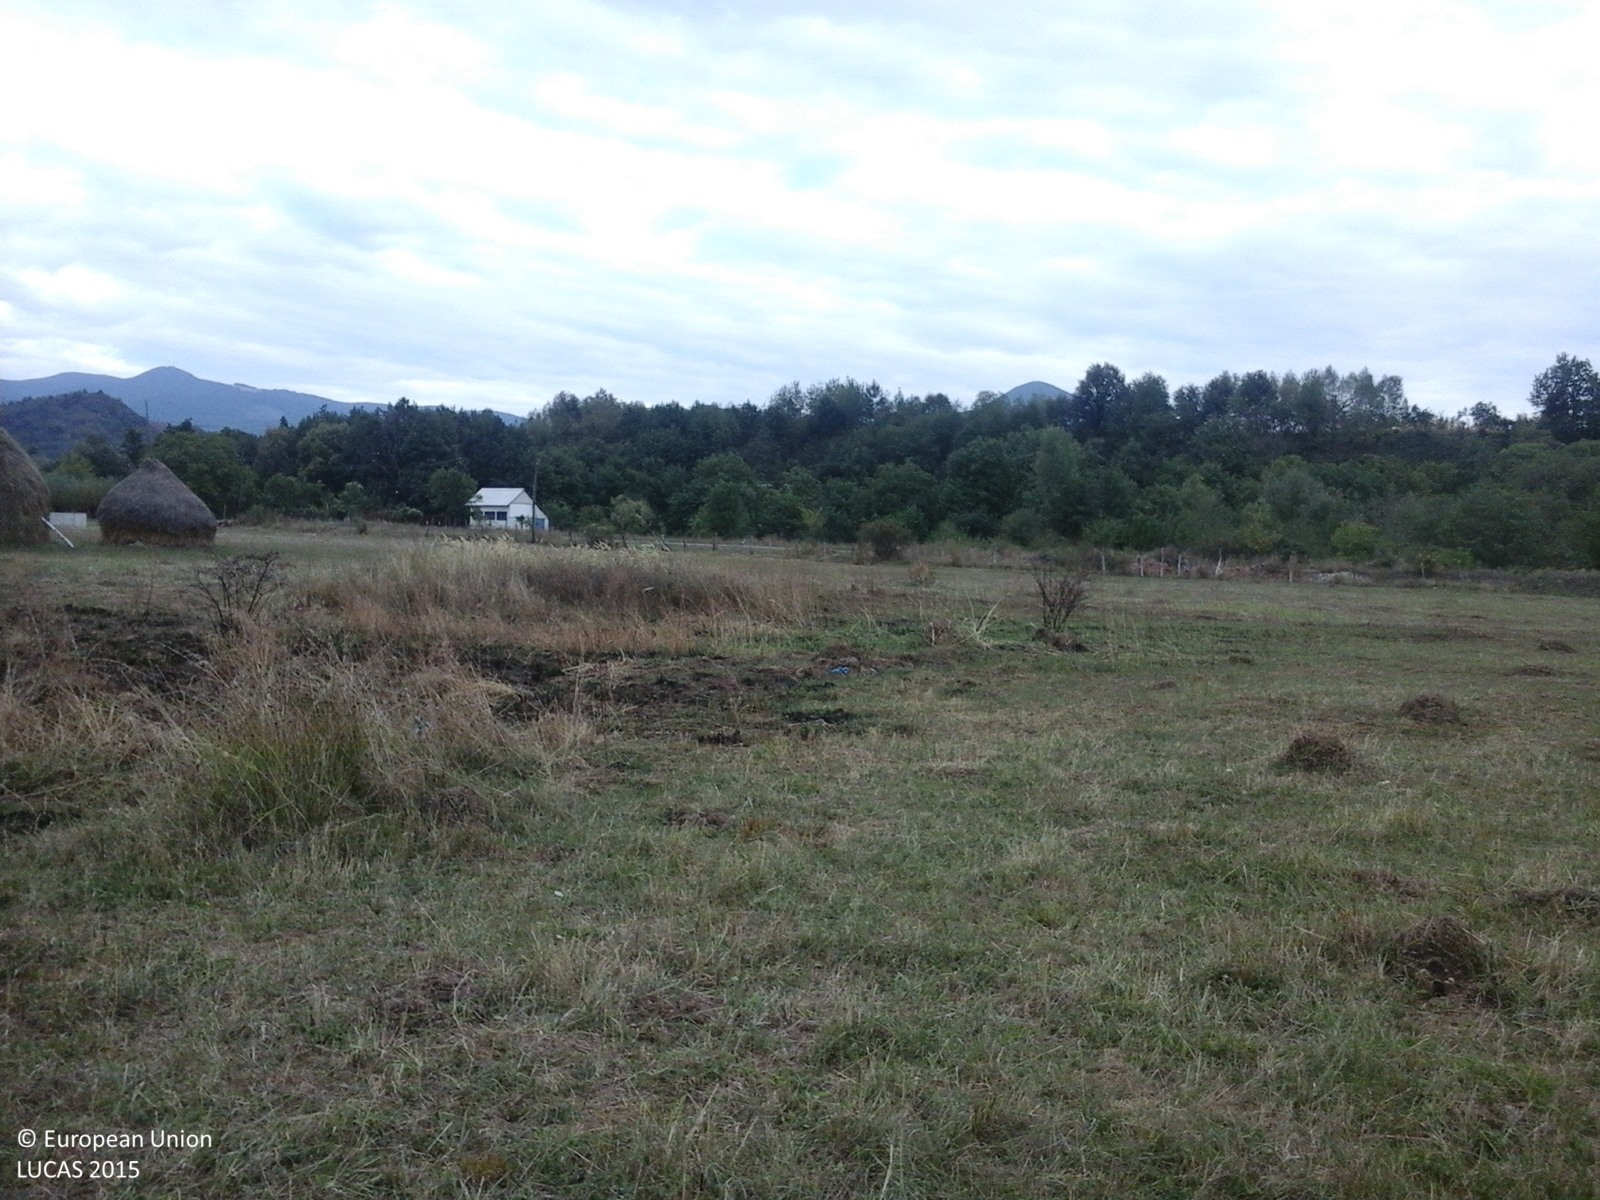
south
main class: Grassland
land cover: Grassland without tree/shrub cover
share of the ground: > 75 %
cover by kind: herbaceous plants 100 %
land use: Agriculture (excluding fallow land and kitchen gardens)
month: September
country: RO
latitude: 47.8536
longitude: 23.4260
